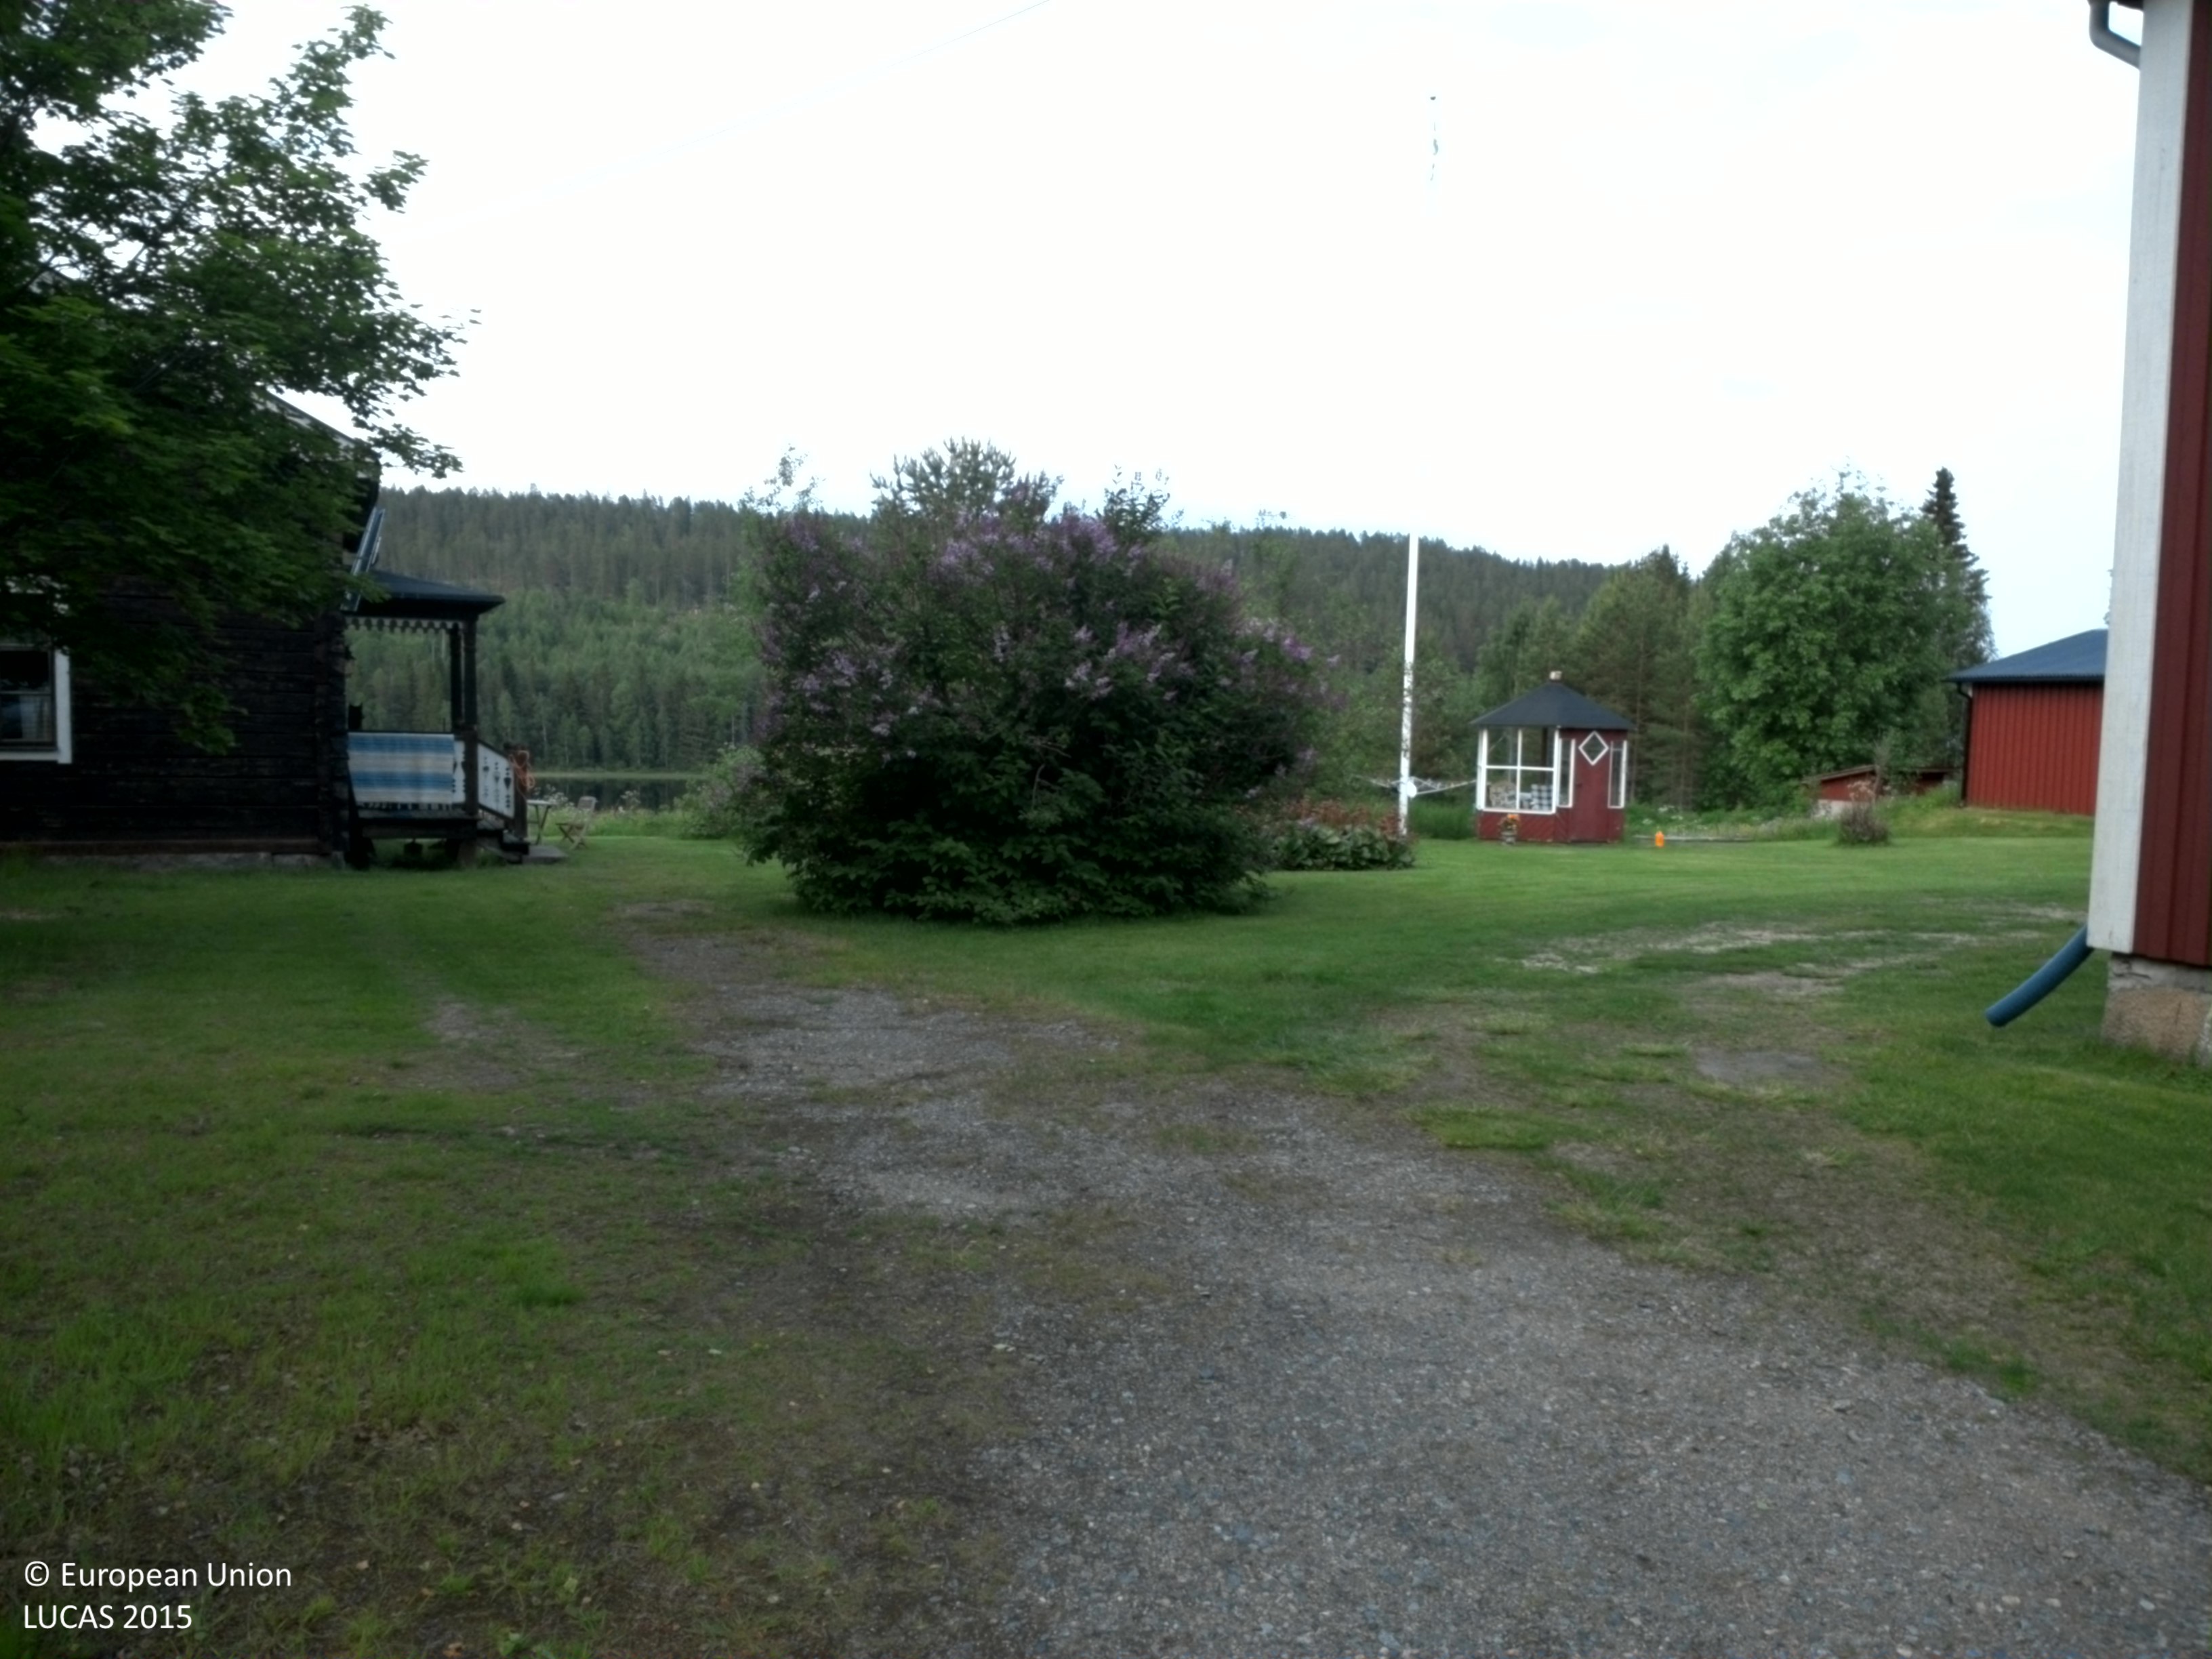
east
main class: Grassland
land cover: Grassland with sparse tree/shrub cover
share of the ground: > 75 %
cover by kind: herbaceous plants 95 %, broadleaved forest trees 5 %
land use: Residential
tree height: > 5 m
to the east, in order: Grassland with sparse tree/shrub cover; Artificial constructions in urban areas; Pine dominated mixed woodland; Grassland without tree/shrub cover; Broadleaved woodland; Inland fresh water bodies
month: July
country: SE
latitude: 64.4812
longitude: 20.8606
